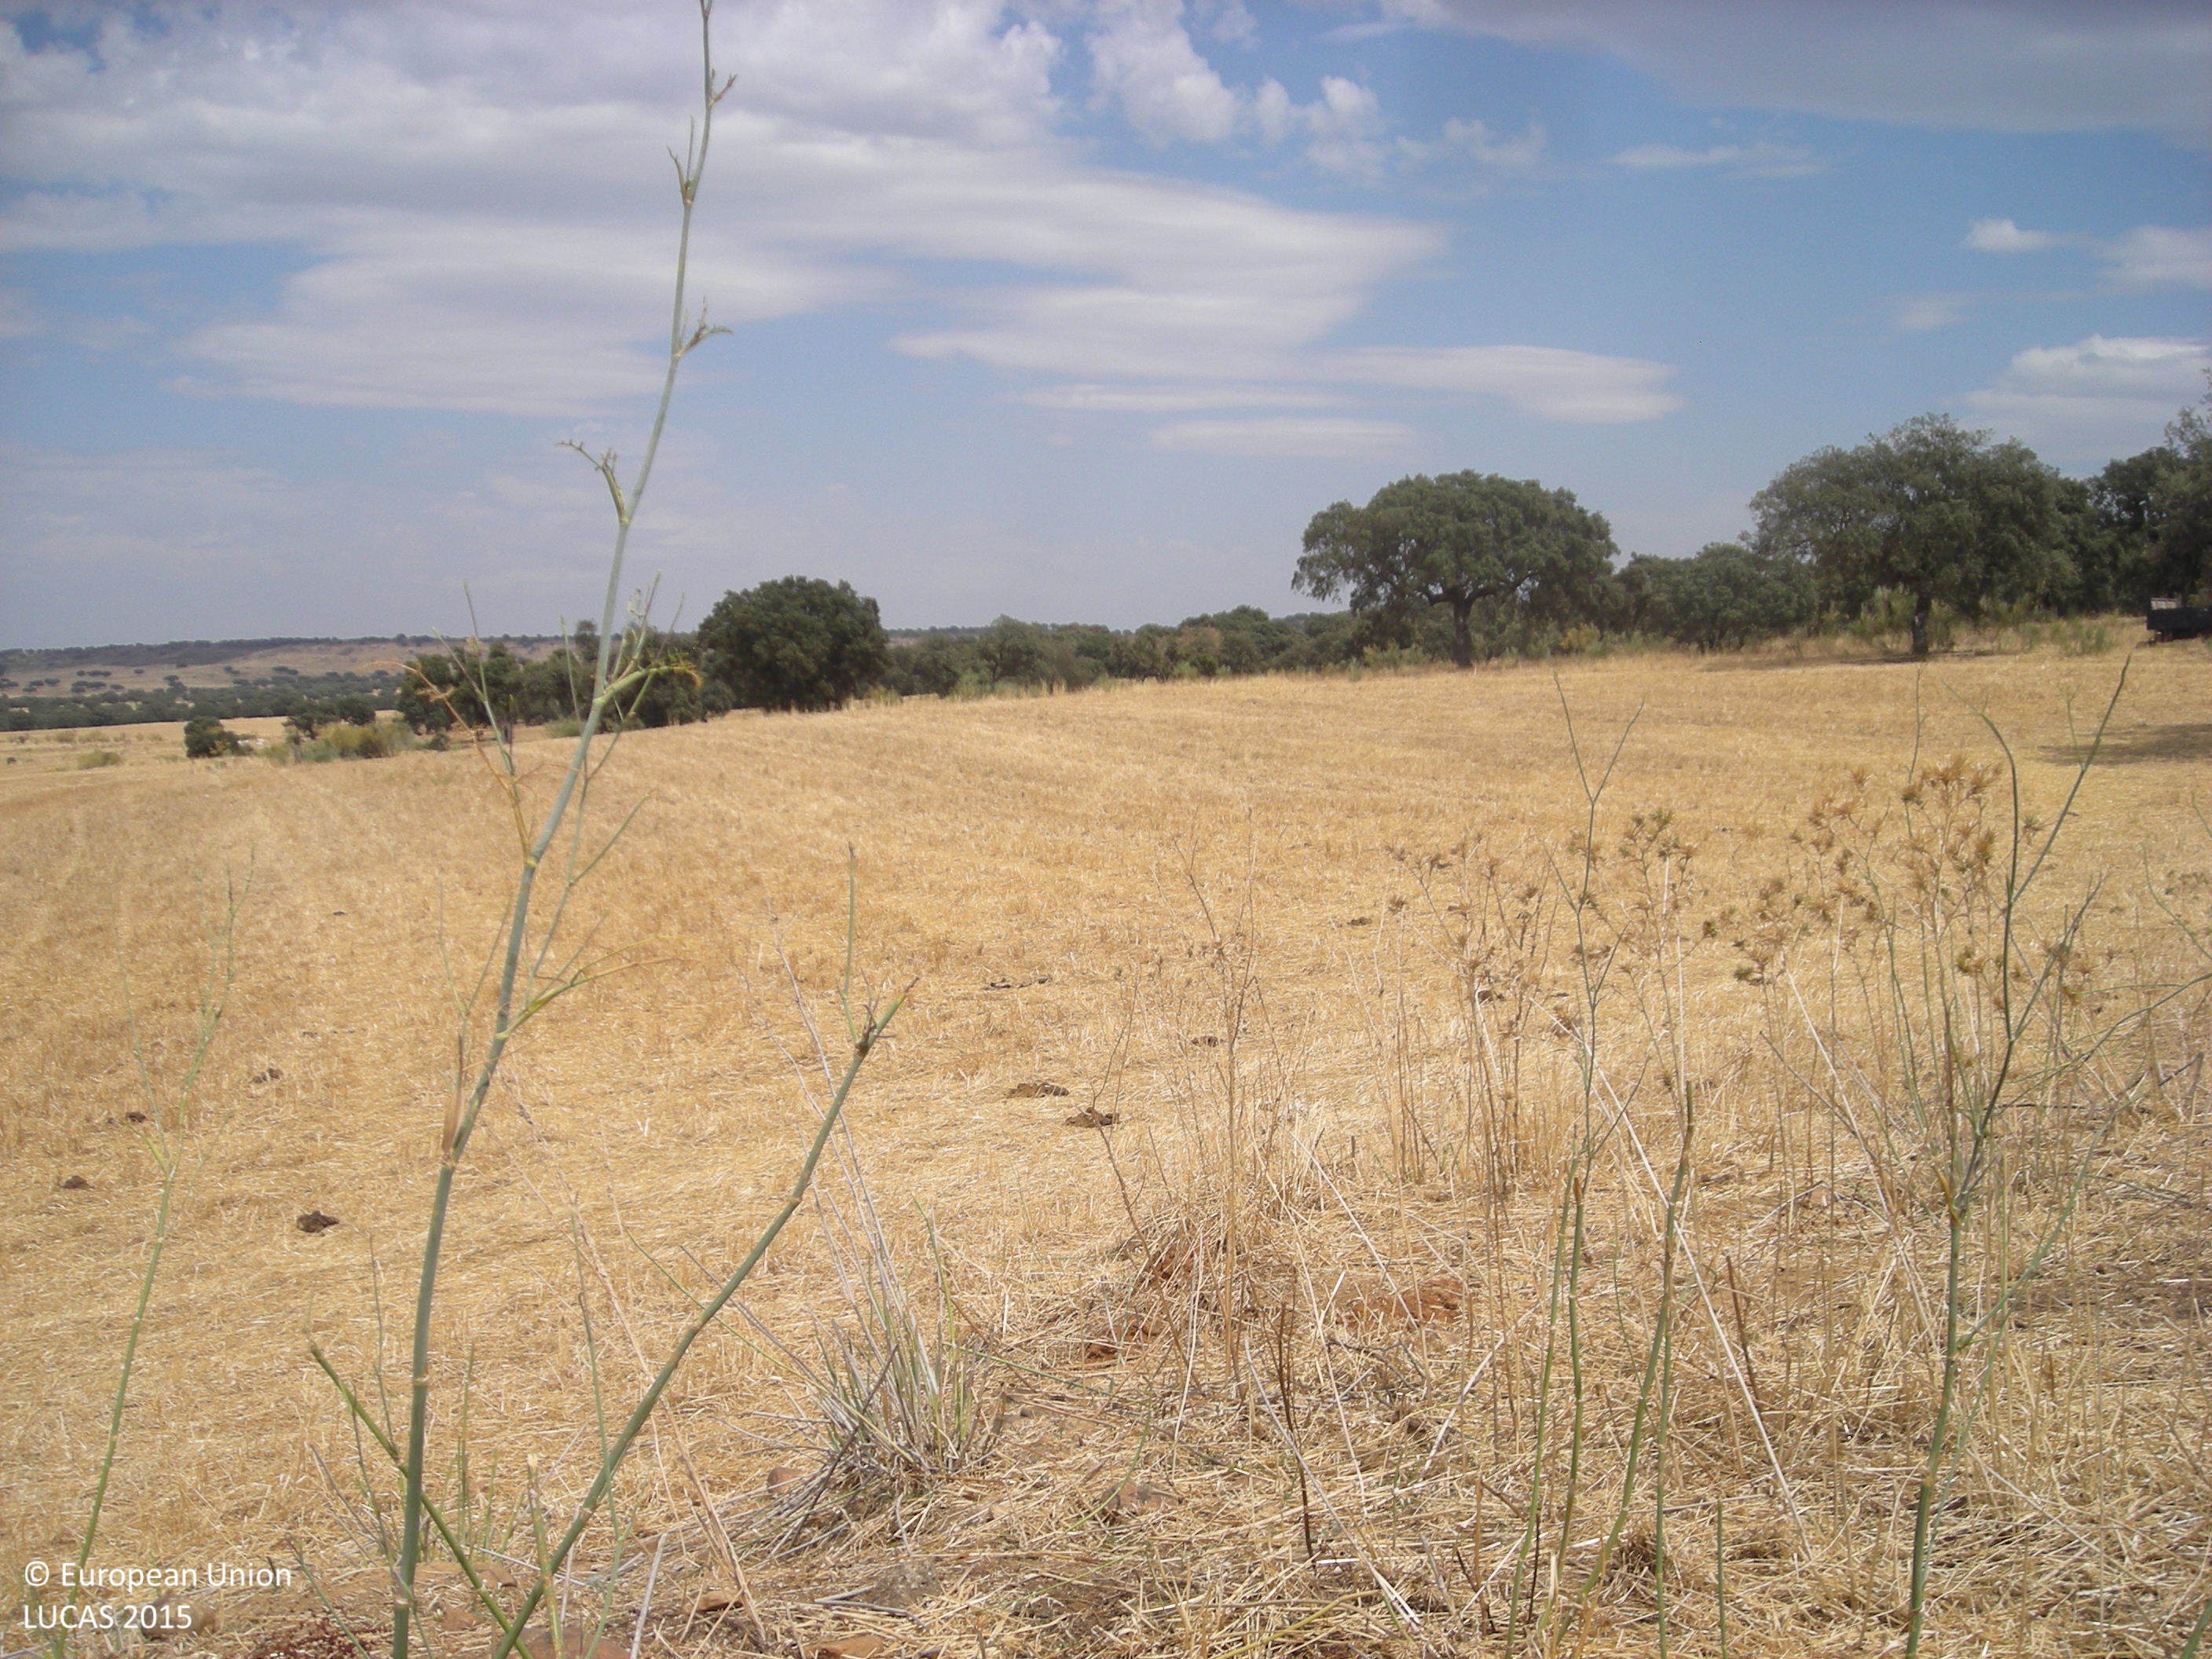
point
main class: Woodland
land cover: Broadleaved woodland
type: broadleaved evergreen forest
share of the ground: > 75 %
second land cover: Grassland without tree/shrub cover
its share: 50 - 75 %
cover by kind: broadleaved forest trees 70 %, herbaceous plants 30 %
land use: Forestry
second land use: Agriculture (excluding fallow land and kitchen gardens)
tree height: > 5 m
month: July
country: ES
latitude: 39.2023
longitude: -5.5533
